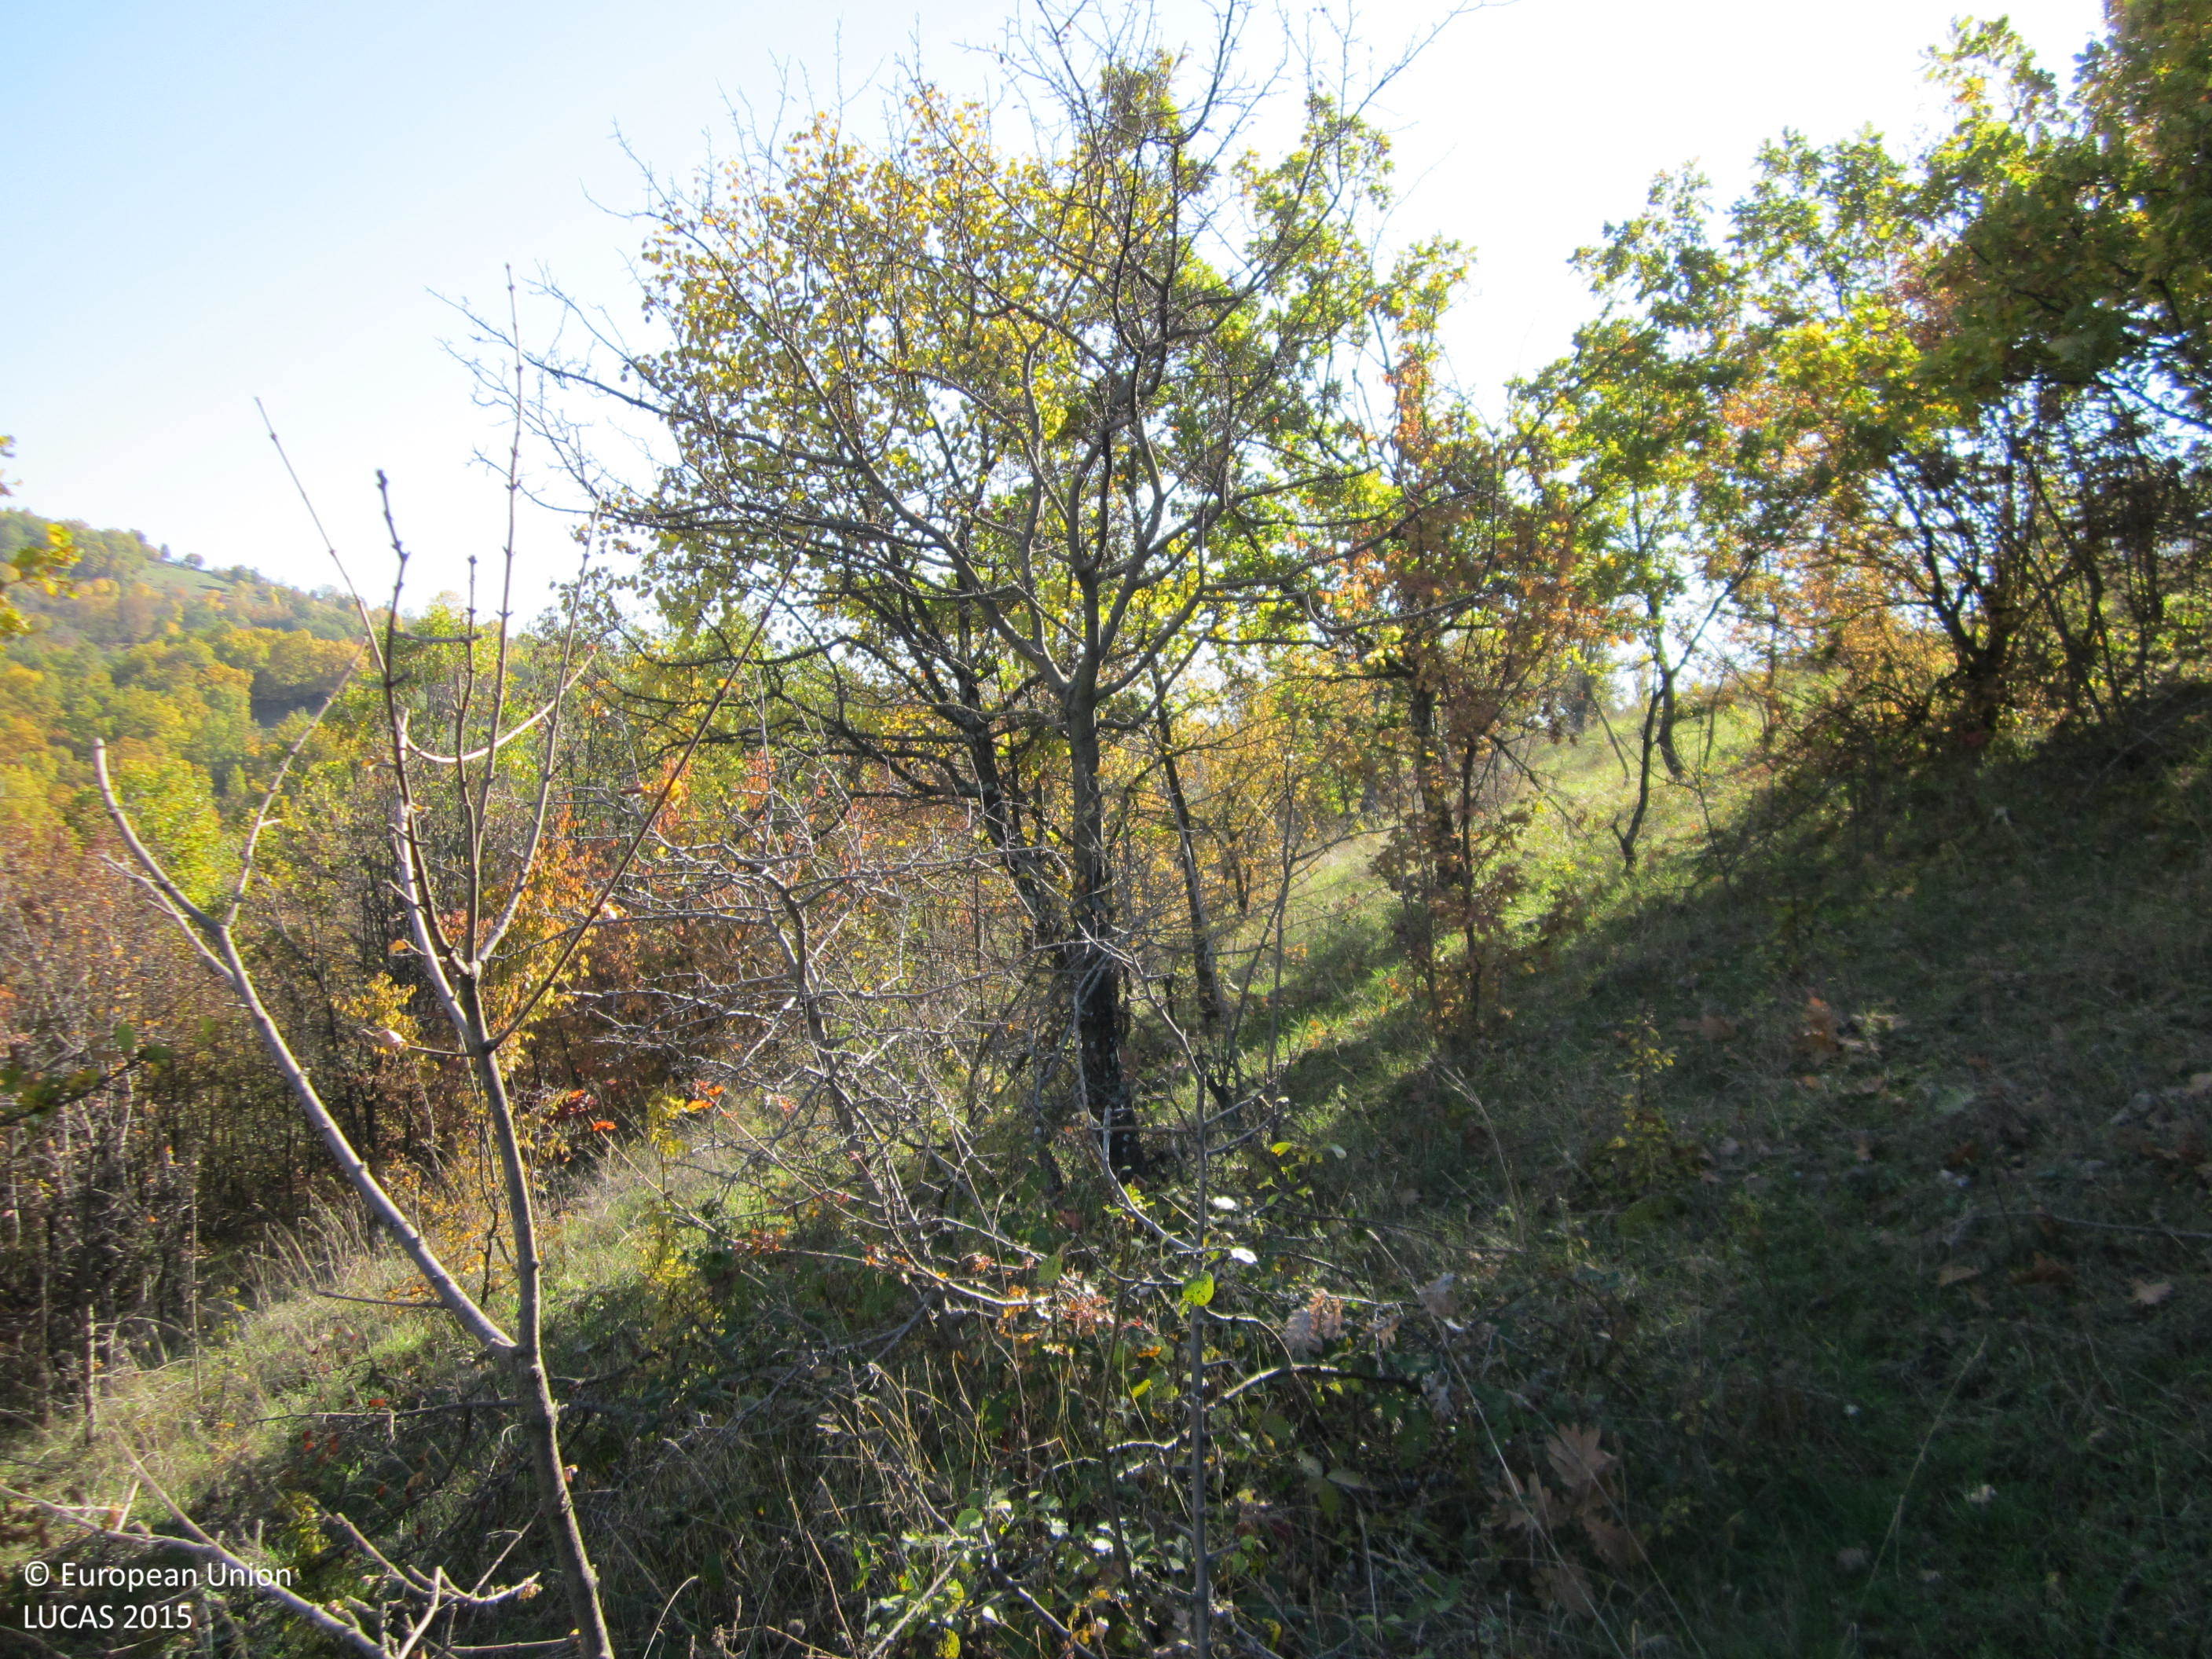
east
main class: Woodland
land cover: Broadleaved woodland
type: acidophilous oak and oak-birch forest
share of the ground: 50 - 75 %
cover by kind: broadleaved forest trees 60 %, herbaceous plants 30 %, shrubs 10 %
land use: Forestry
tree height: > 5 m
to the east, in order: Broadleaved woodland; Rivers and streams; Broadleaved woodland; Grassland with sparse tree/shrub cover; Broadleaved woodland
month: November
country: BG
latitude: 41.5315
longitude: 25.5805
